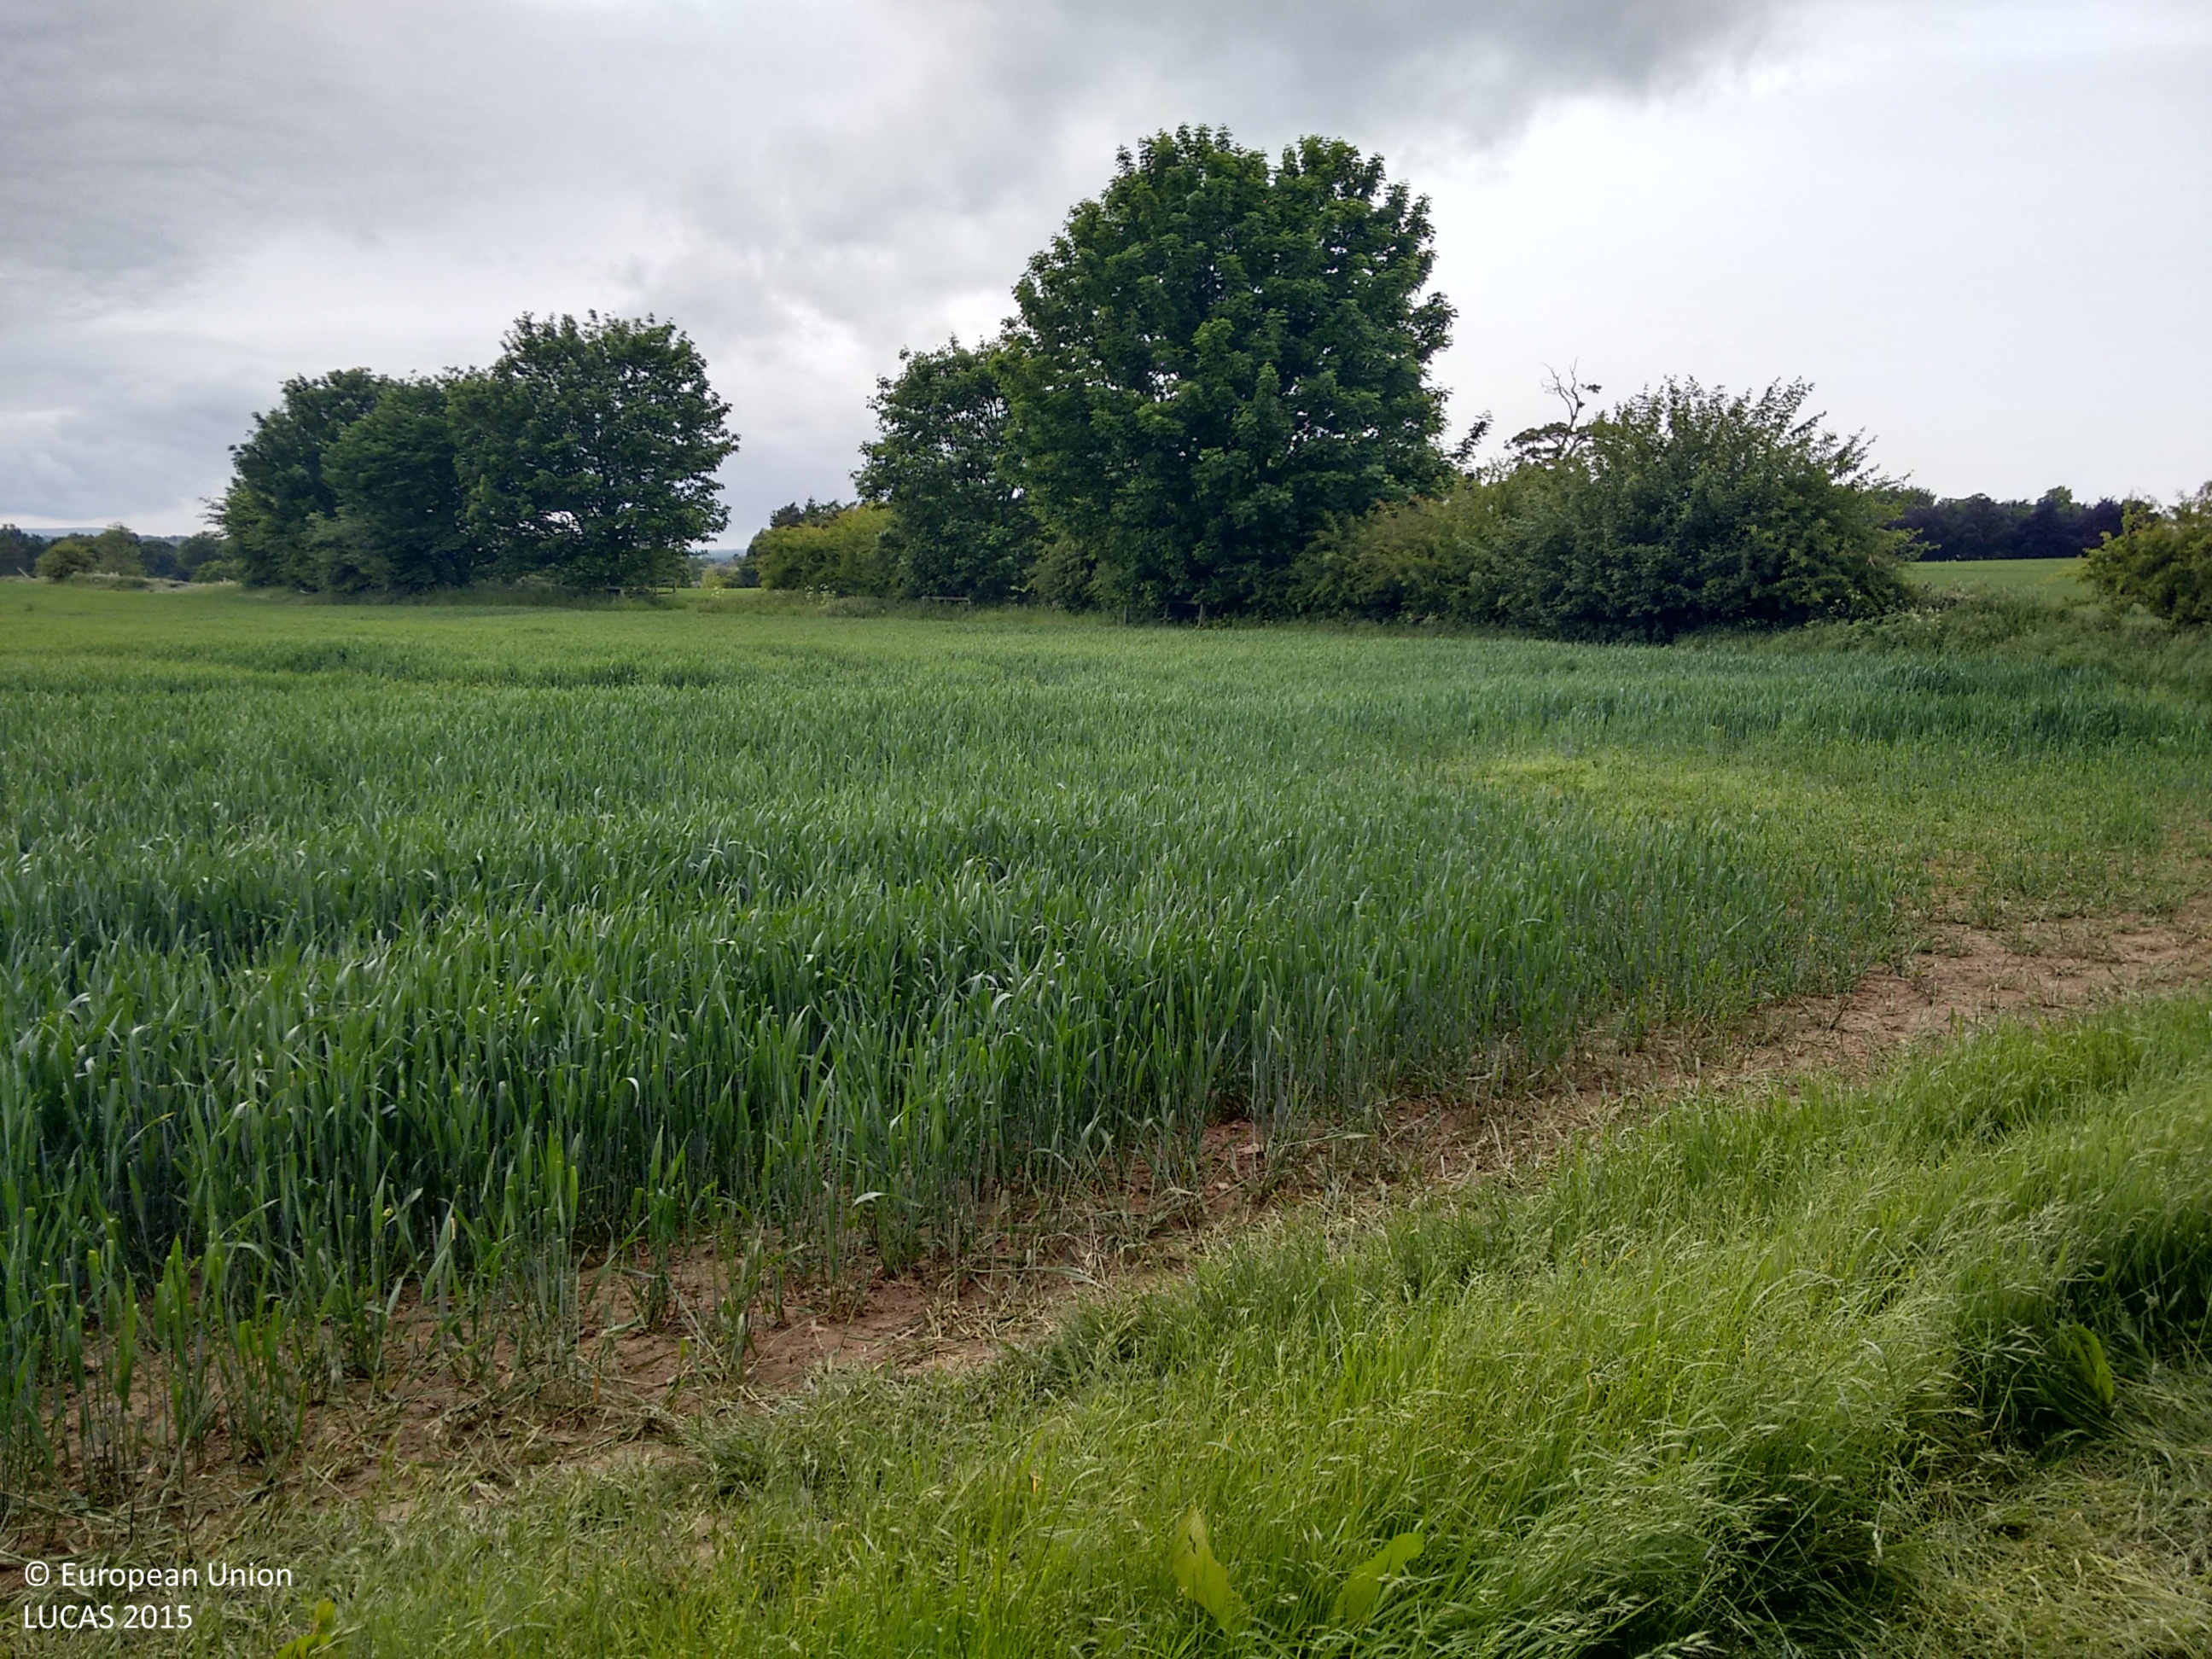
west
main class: Woodland
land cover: Broadleaved woodland
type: mesophytic deciduous forest
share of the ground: > 75 %
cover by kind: broadleaved forest trees 100 %
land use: Forestry
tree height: > 5 m
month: June
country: GB
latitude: 54.3091
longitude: -1.6552
